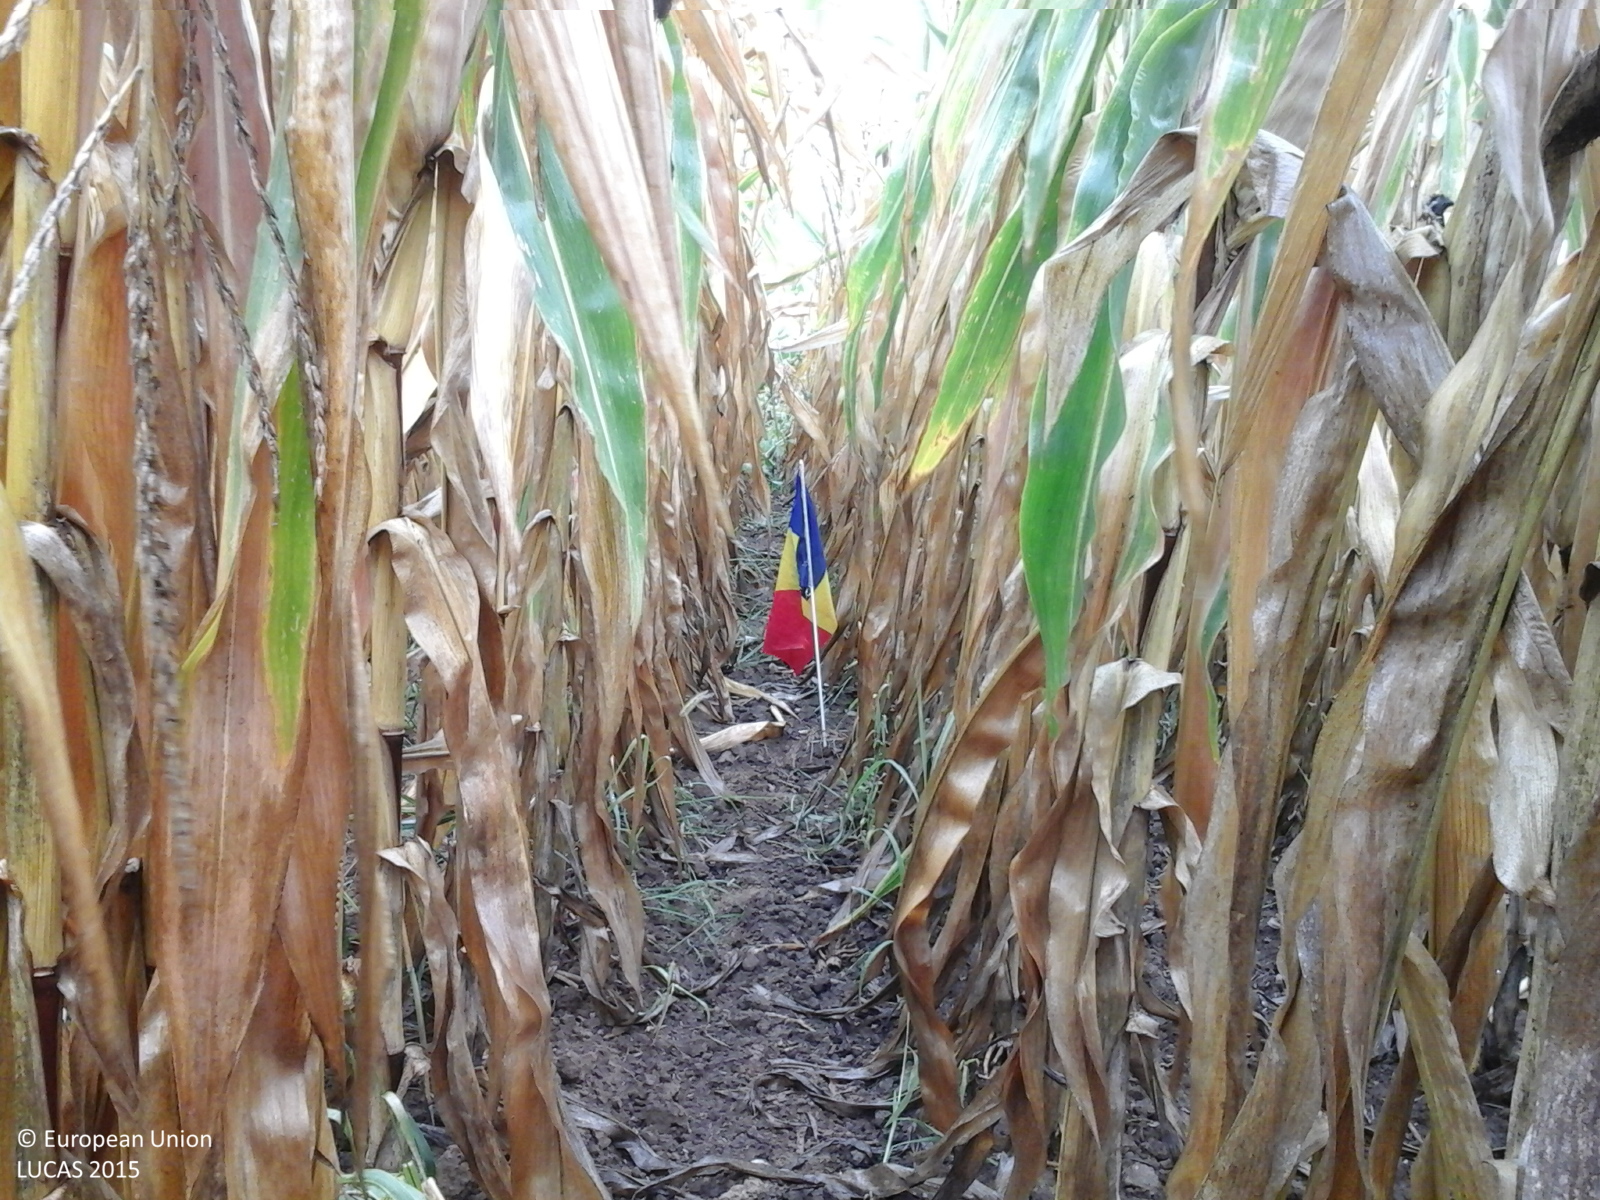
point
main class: Cropland
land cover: Maize
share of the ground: > 75 %
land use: Agriculture (excluding fallow land and kitchen gardens)
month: September
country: RO
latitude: 47.4888
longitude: 22.1966
